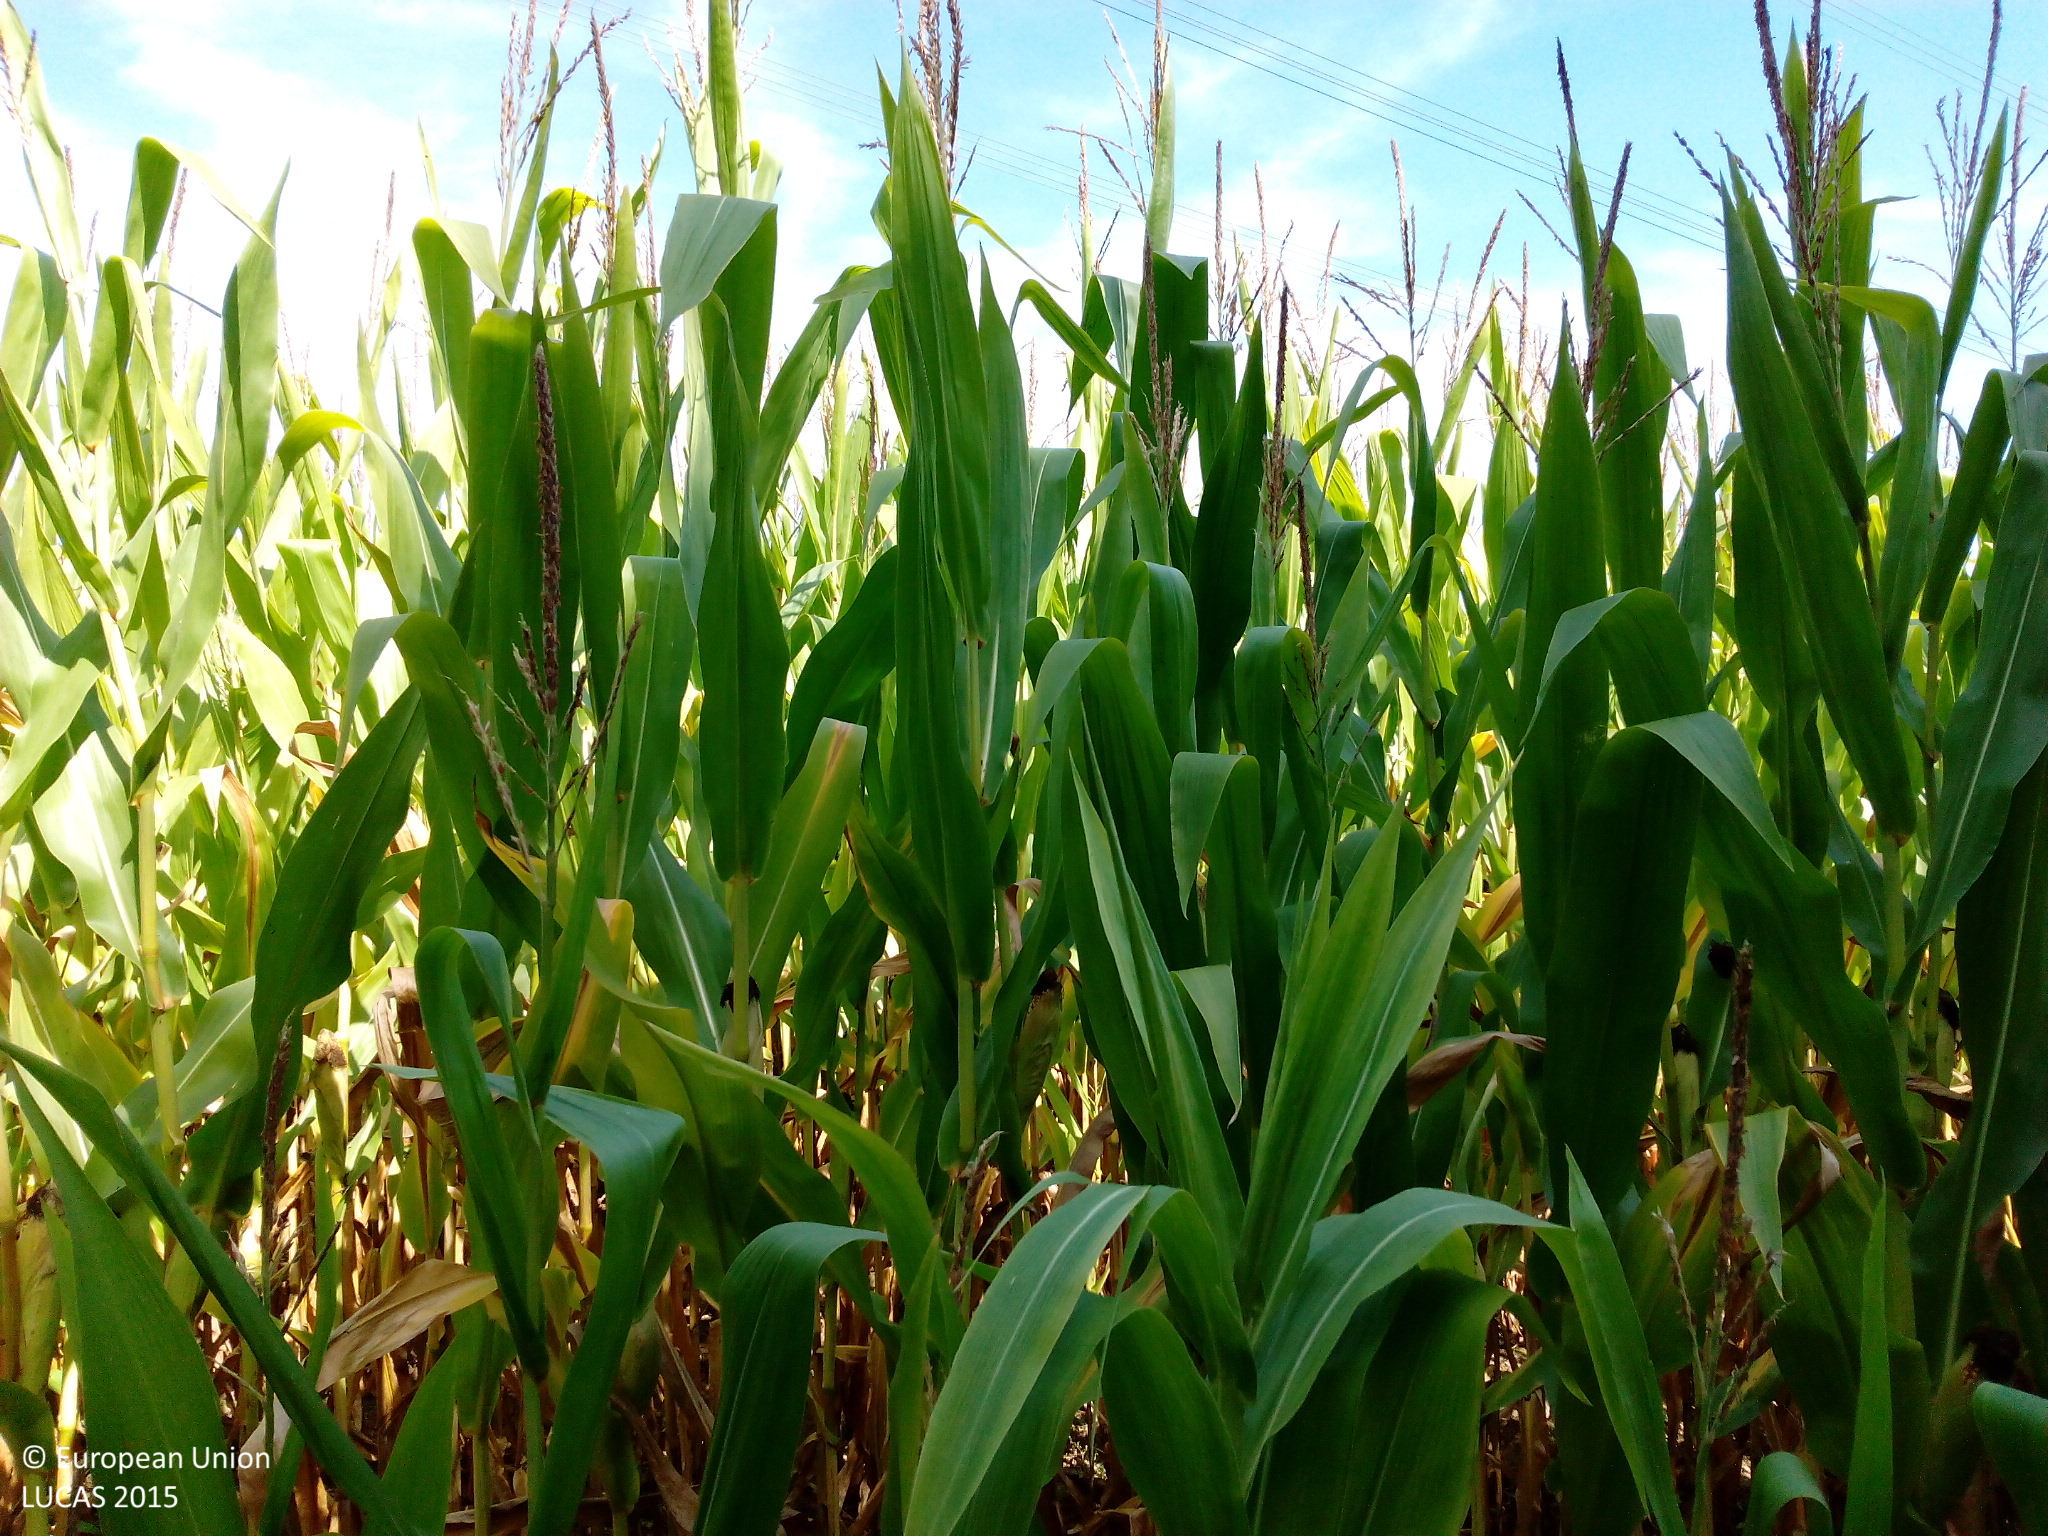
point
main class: Cropland
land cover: Maize
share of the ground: > 75 %
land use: Agriculture (excluding fallow land and kitchen gardens)
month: August
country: DE
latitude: 48.2775
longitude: 9.9327
